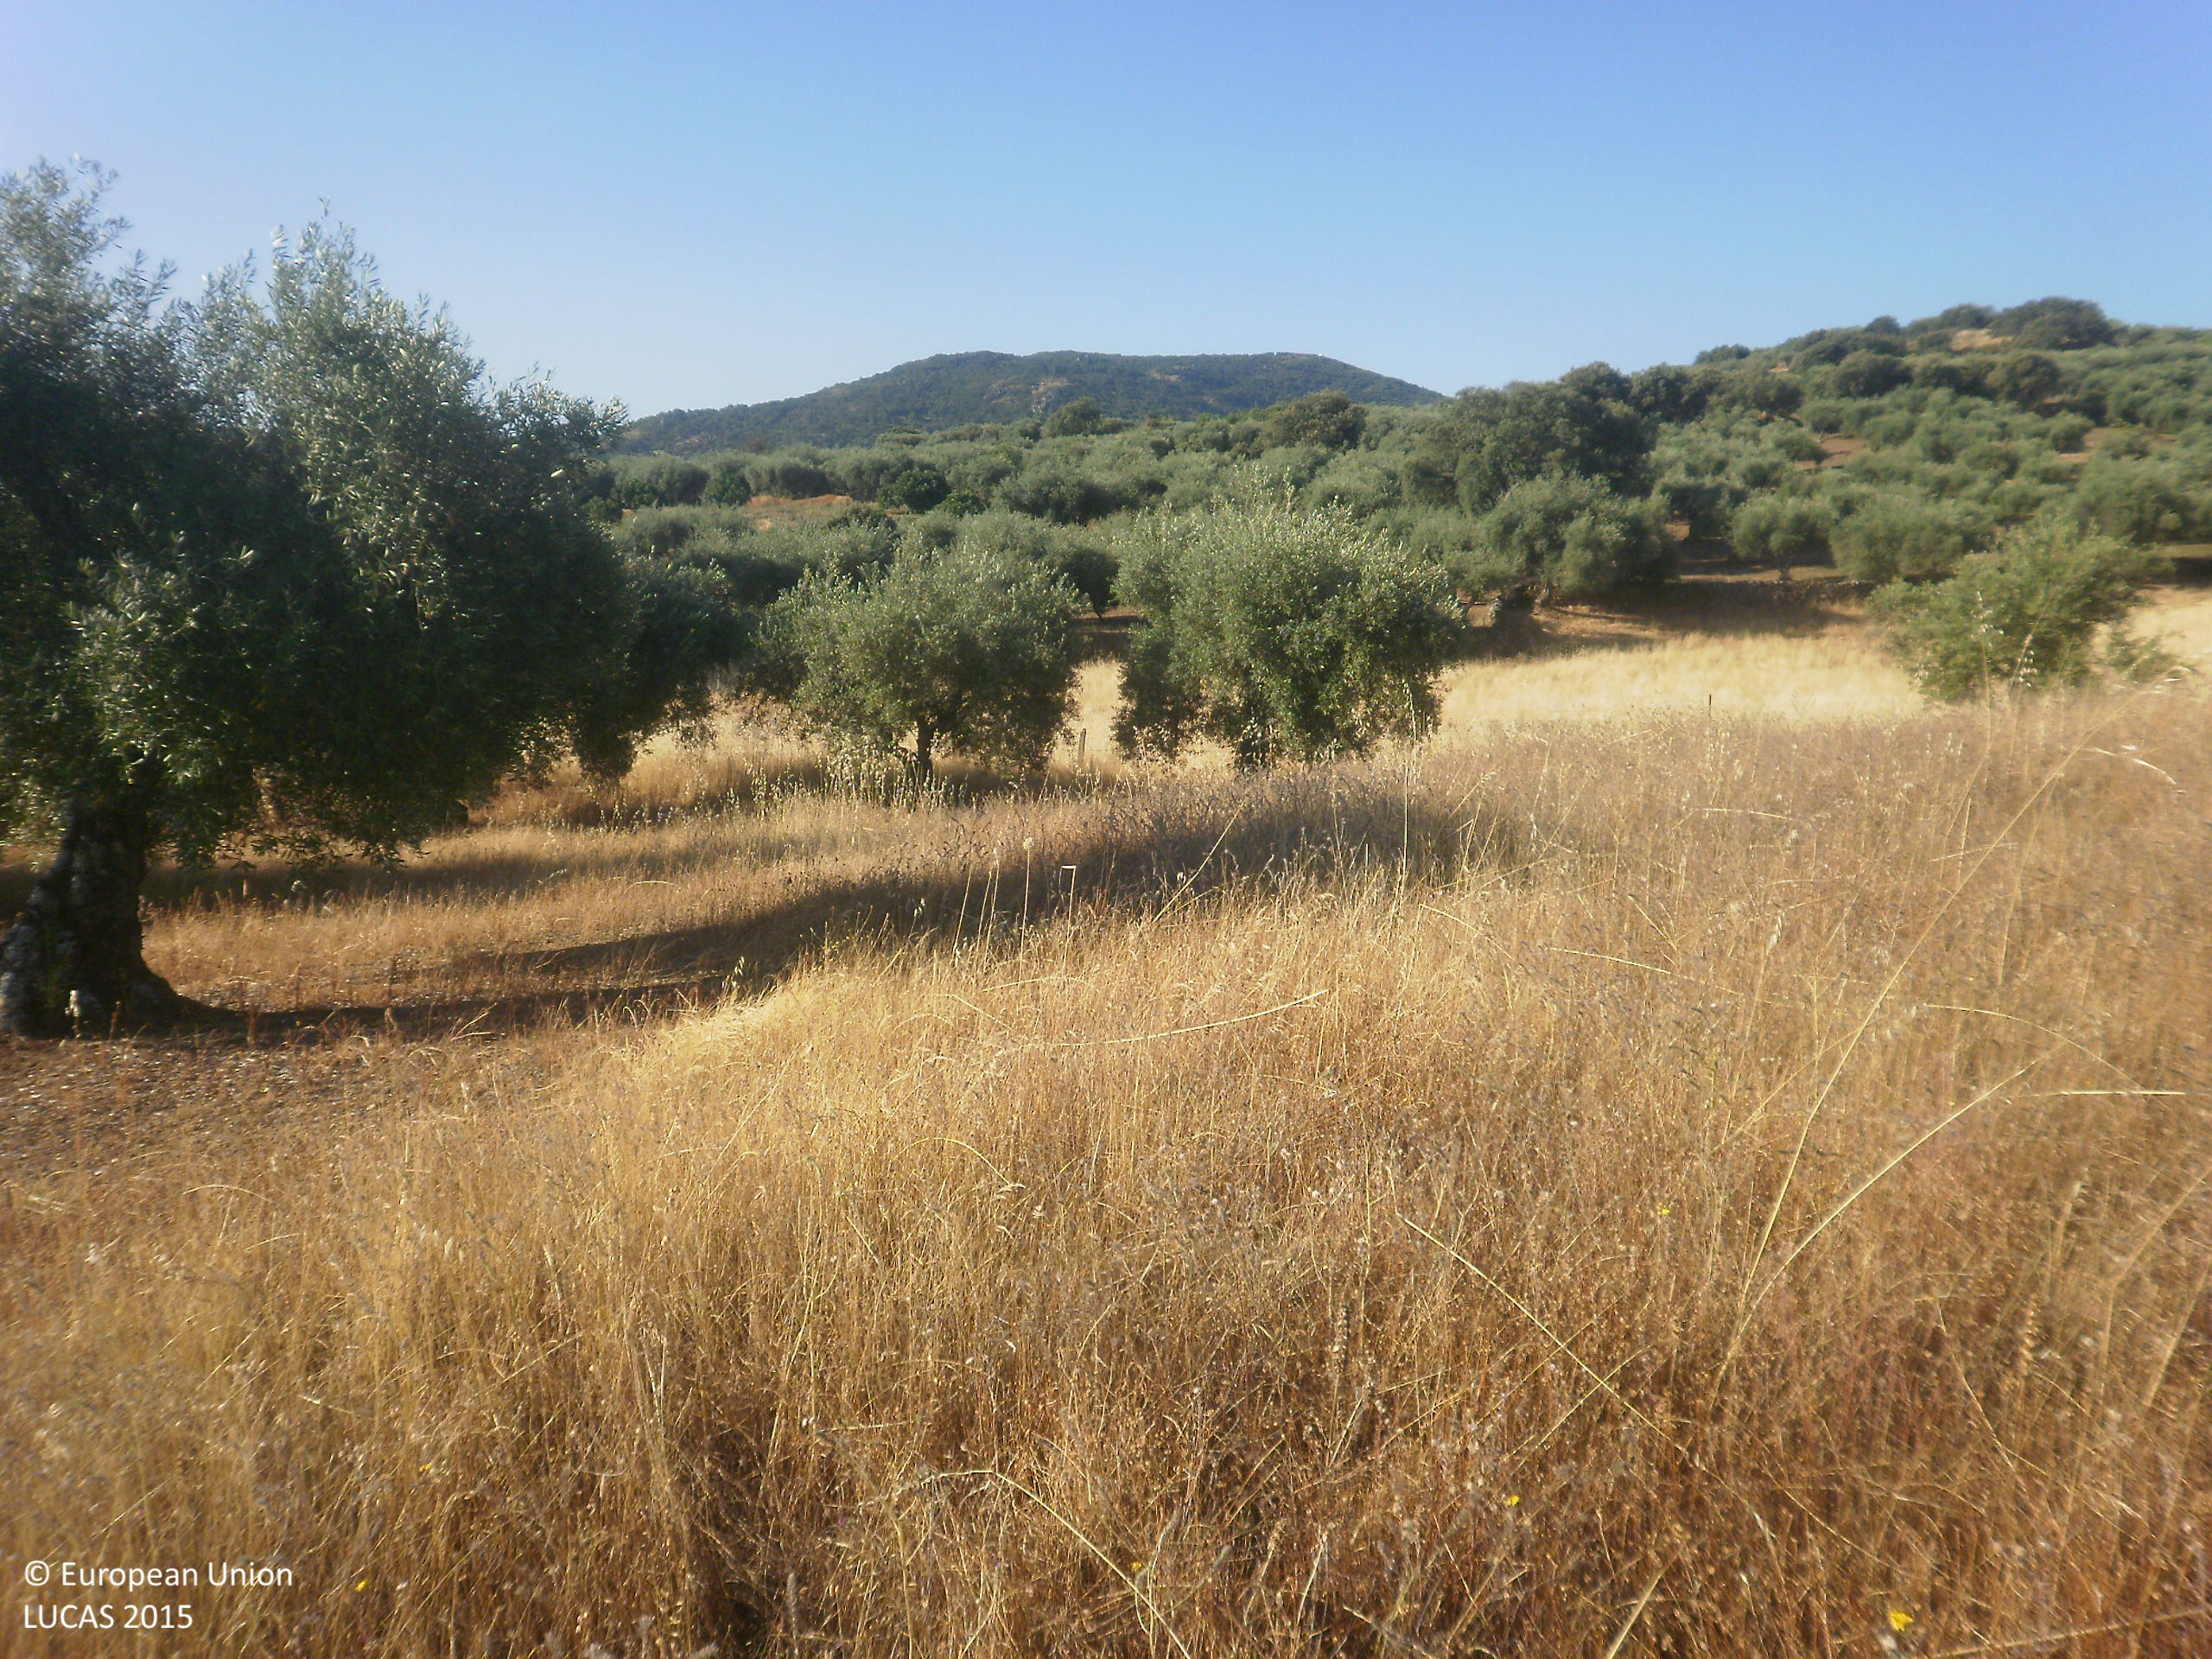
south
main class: Cropland
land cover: Olive groves
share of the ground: 50 - 75 %
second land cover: Grassland without tree/shrub cover
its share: 25 - 50 %
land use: Agriculture (excluding fallow land and kitchen gardens)
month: June
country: ES
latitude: 39.2513
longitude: -6.0371
